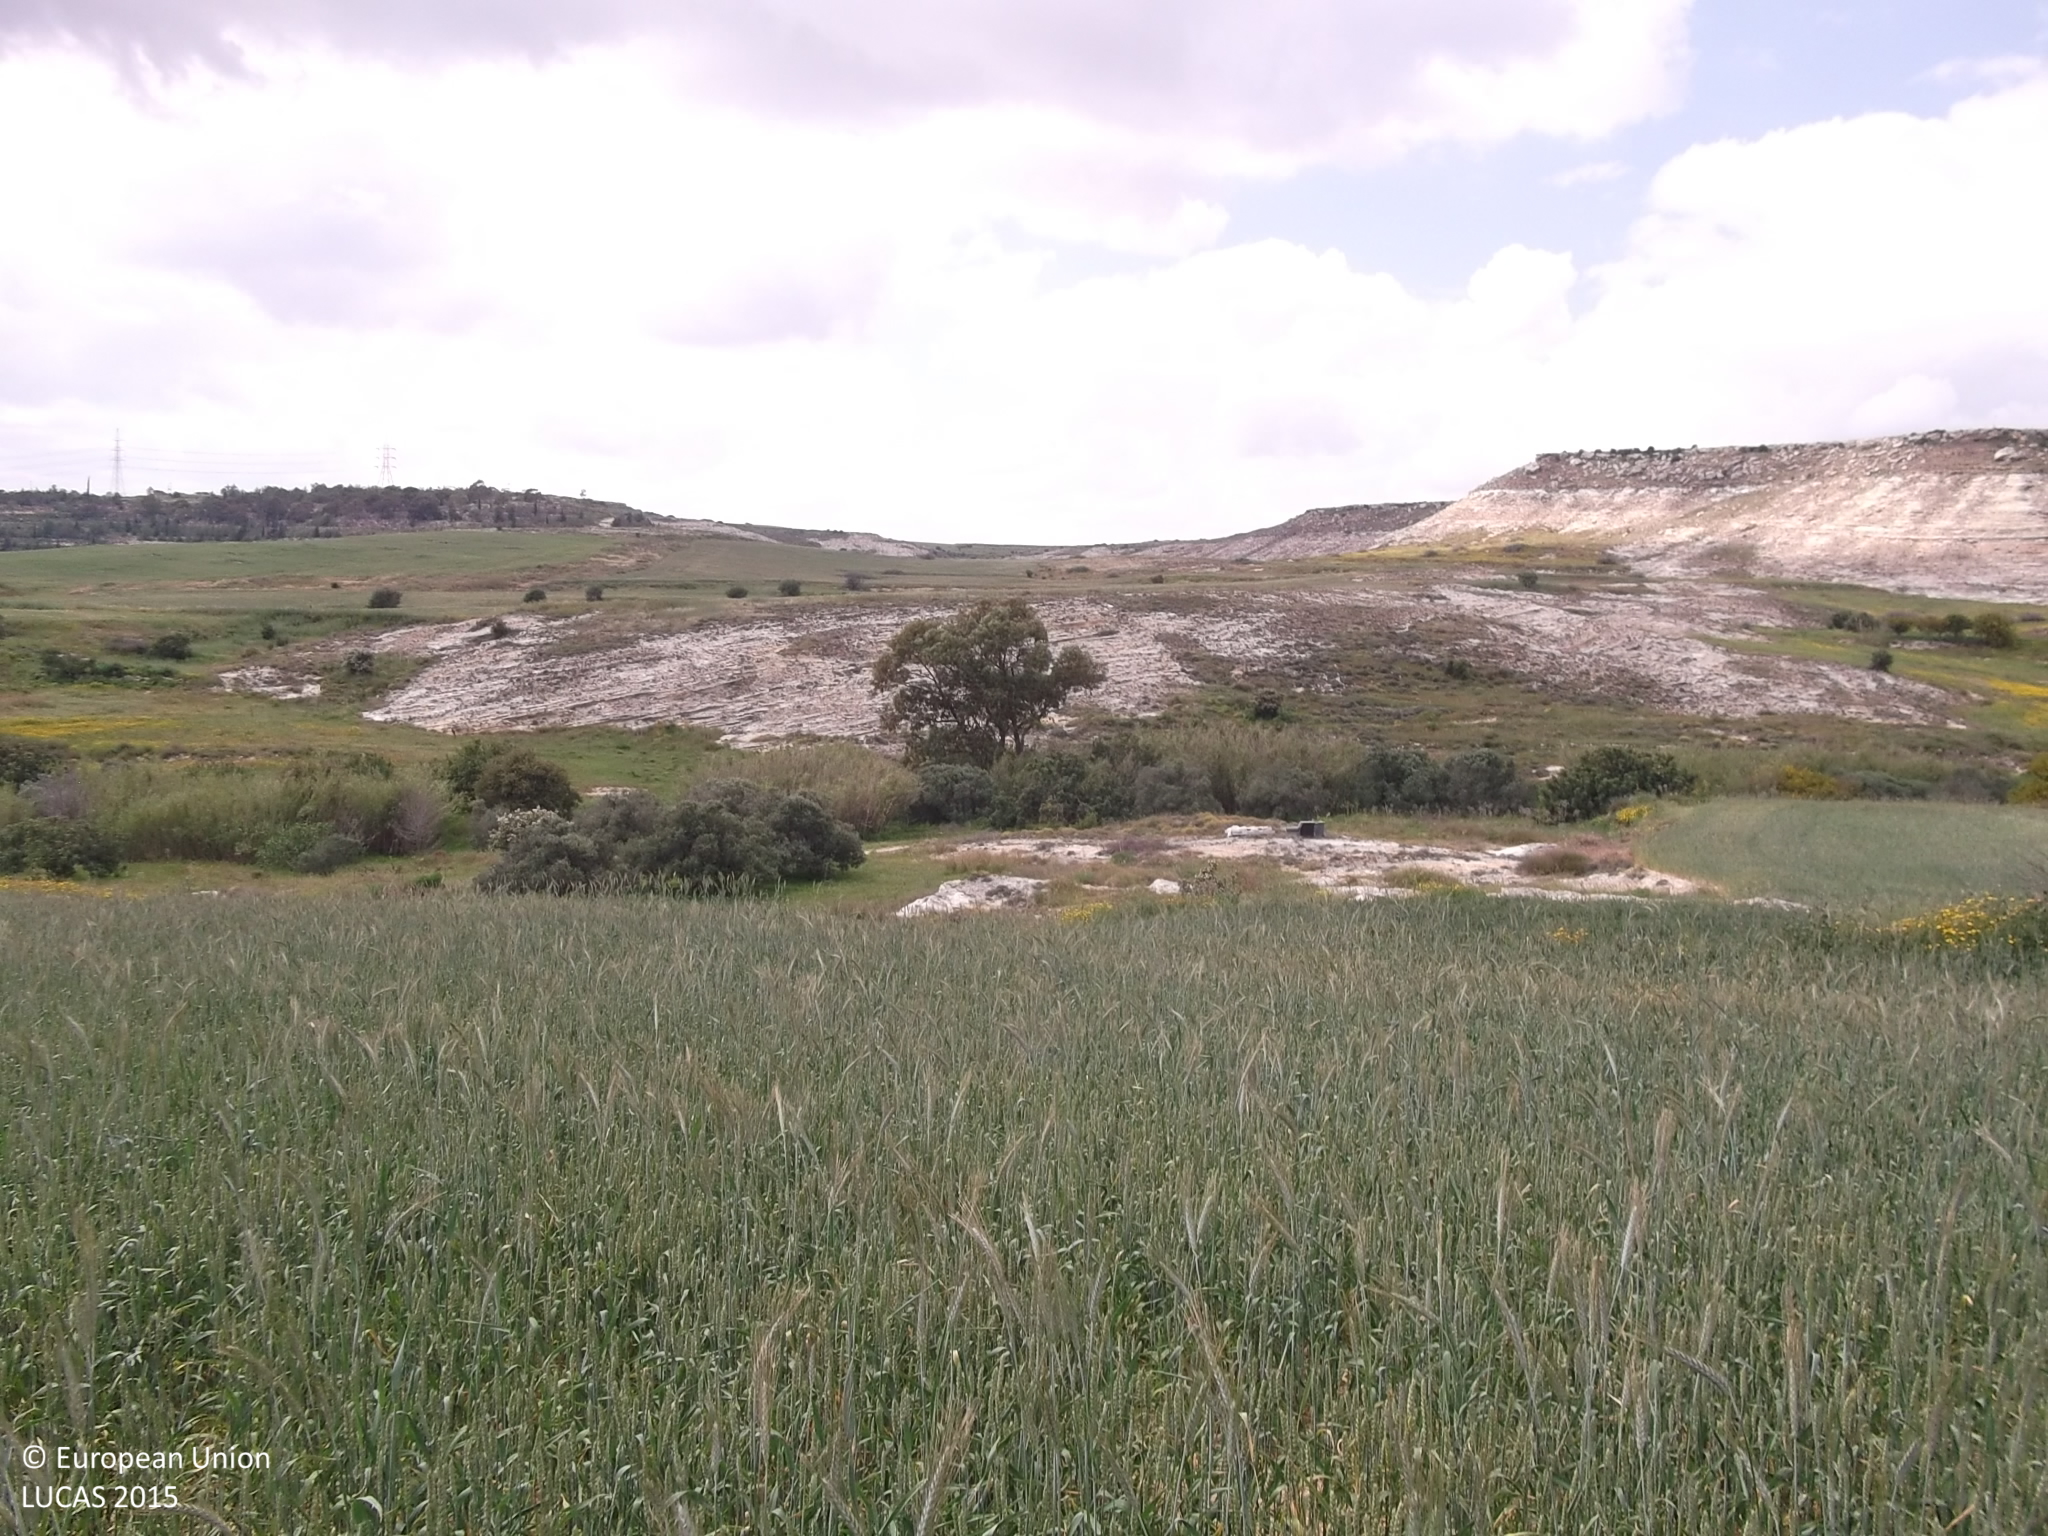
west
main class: Cropland
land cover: Common wheat
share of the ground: > 75 %
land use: Agriculture (excluding fallow land and kitchen gardens)
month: April
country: CY
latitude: 35.0103
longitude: 33.6853
